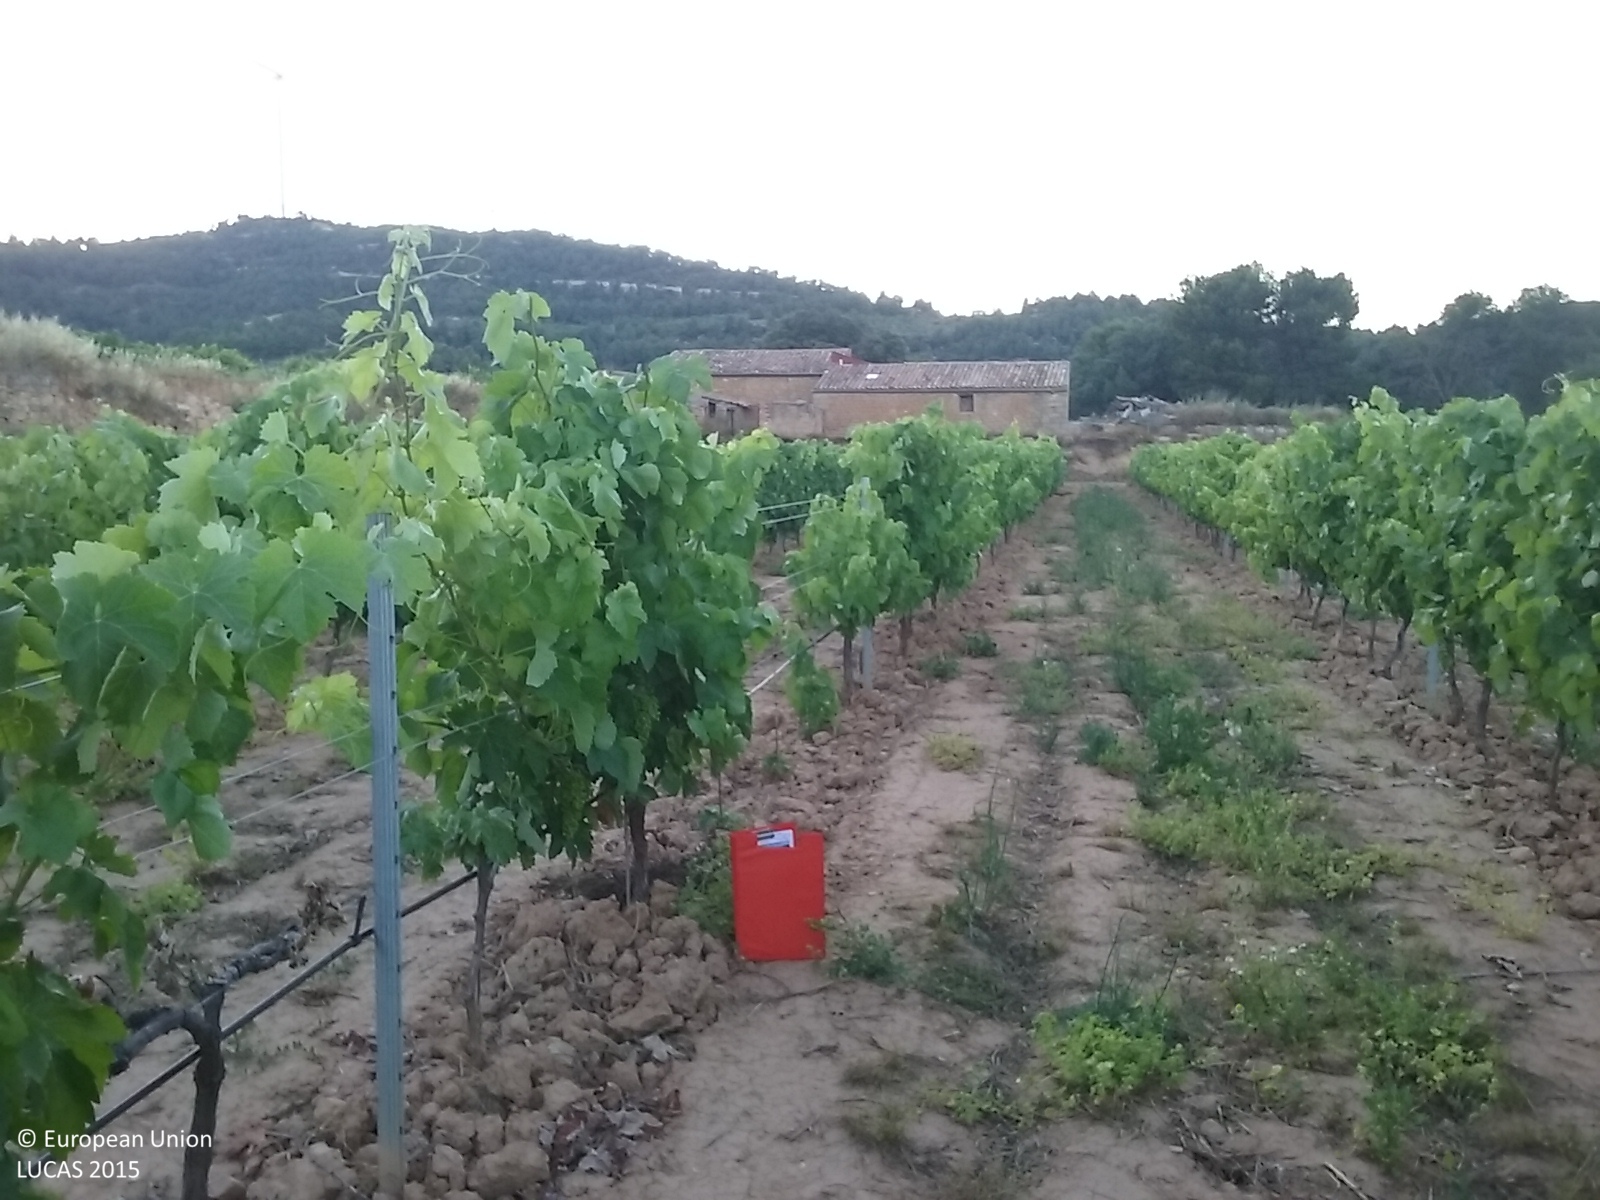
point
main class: Cropland
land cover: Vineyards
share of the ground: 10 - 25 %
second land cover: Spontaneously vegetated surfaces
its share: 10 - 25 %
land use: Agriculture (excluding fallow land and kitchen gardens)
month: June
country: ES
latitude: 41.0100
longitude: 0.3484
